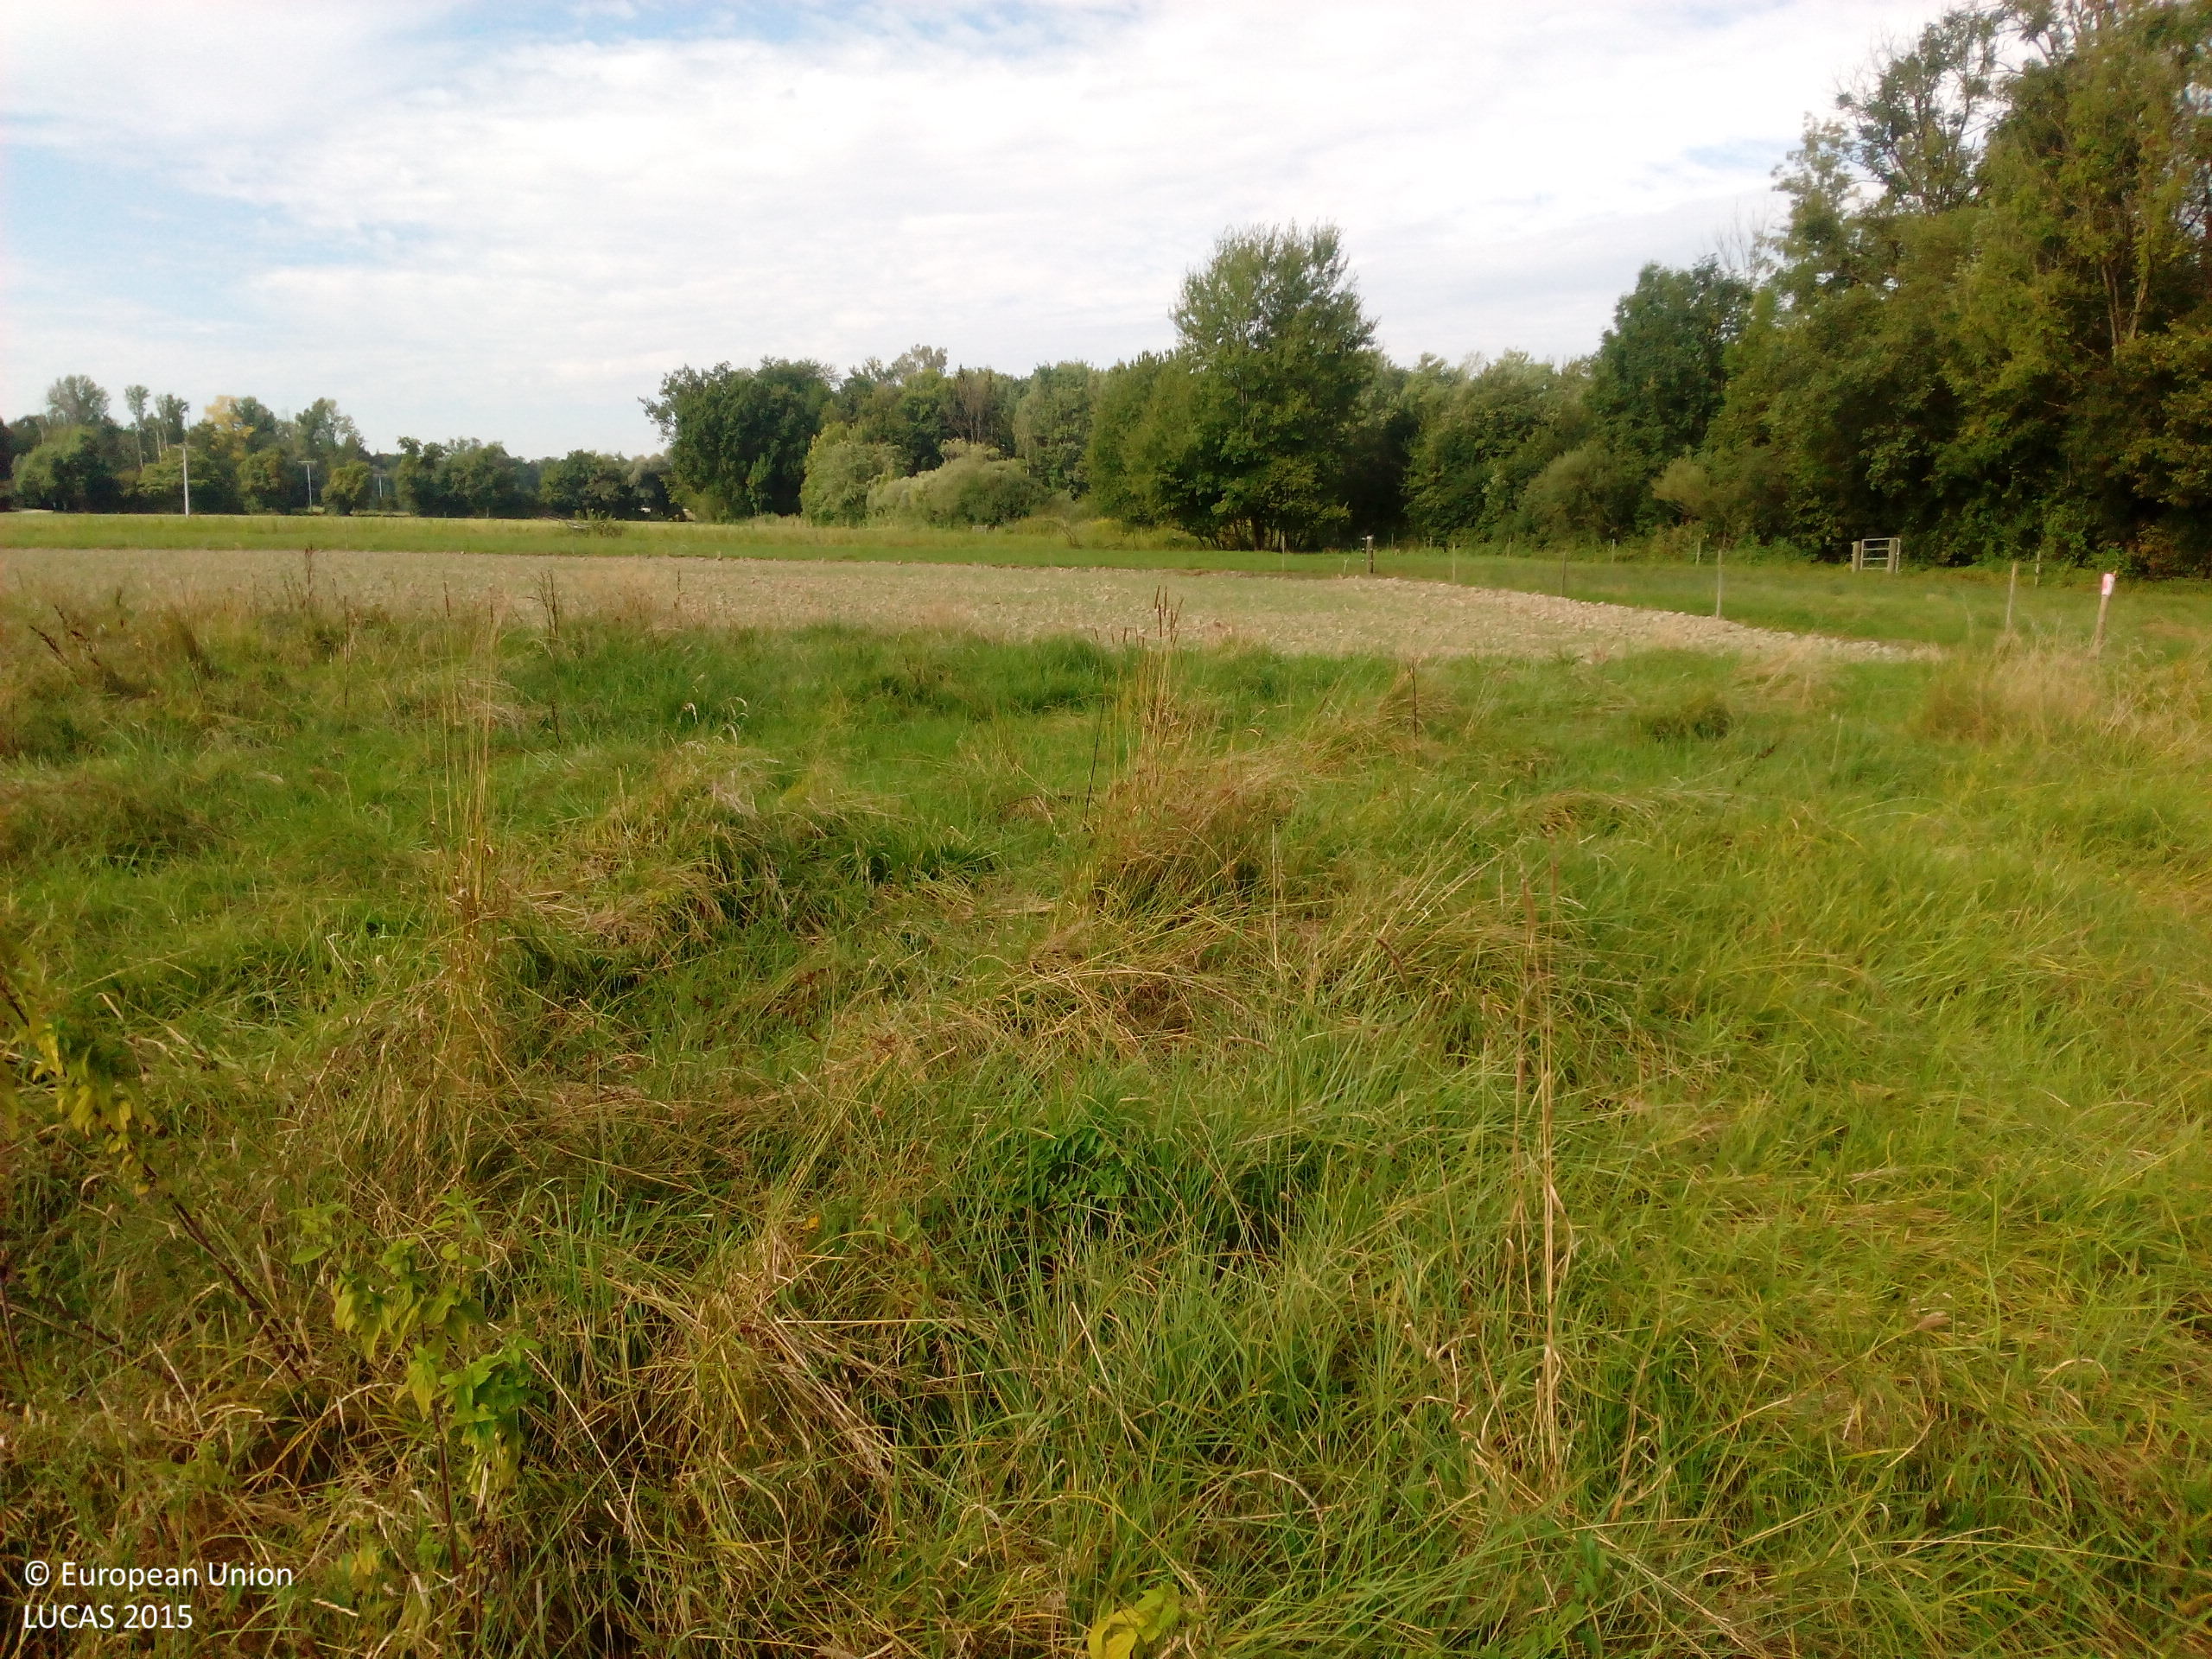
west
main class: Grassland
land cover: Grassland without tree/shrub cover
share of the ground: > 75 %
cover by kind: herbaceous plants 100 %
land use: Agriculture (excluding fallow land and kitchen gardens)
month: August
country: DE
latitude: 48.7782
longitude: 12.9525
